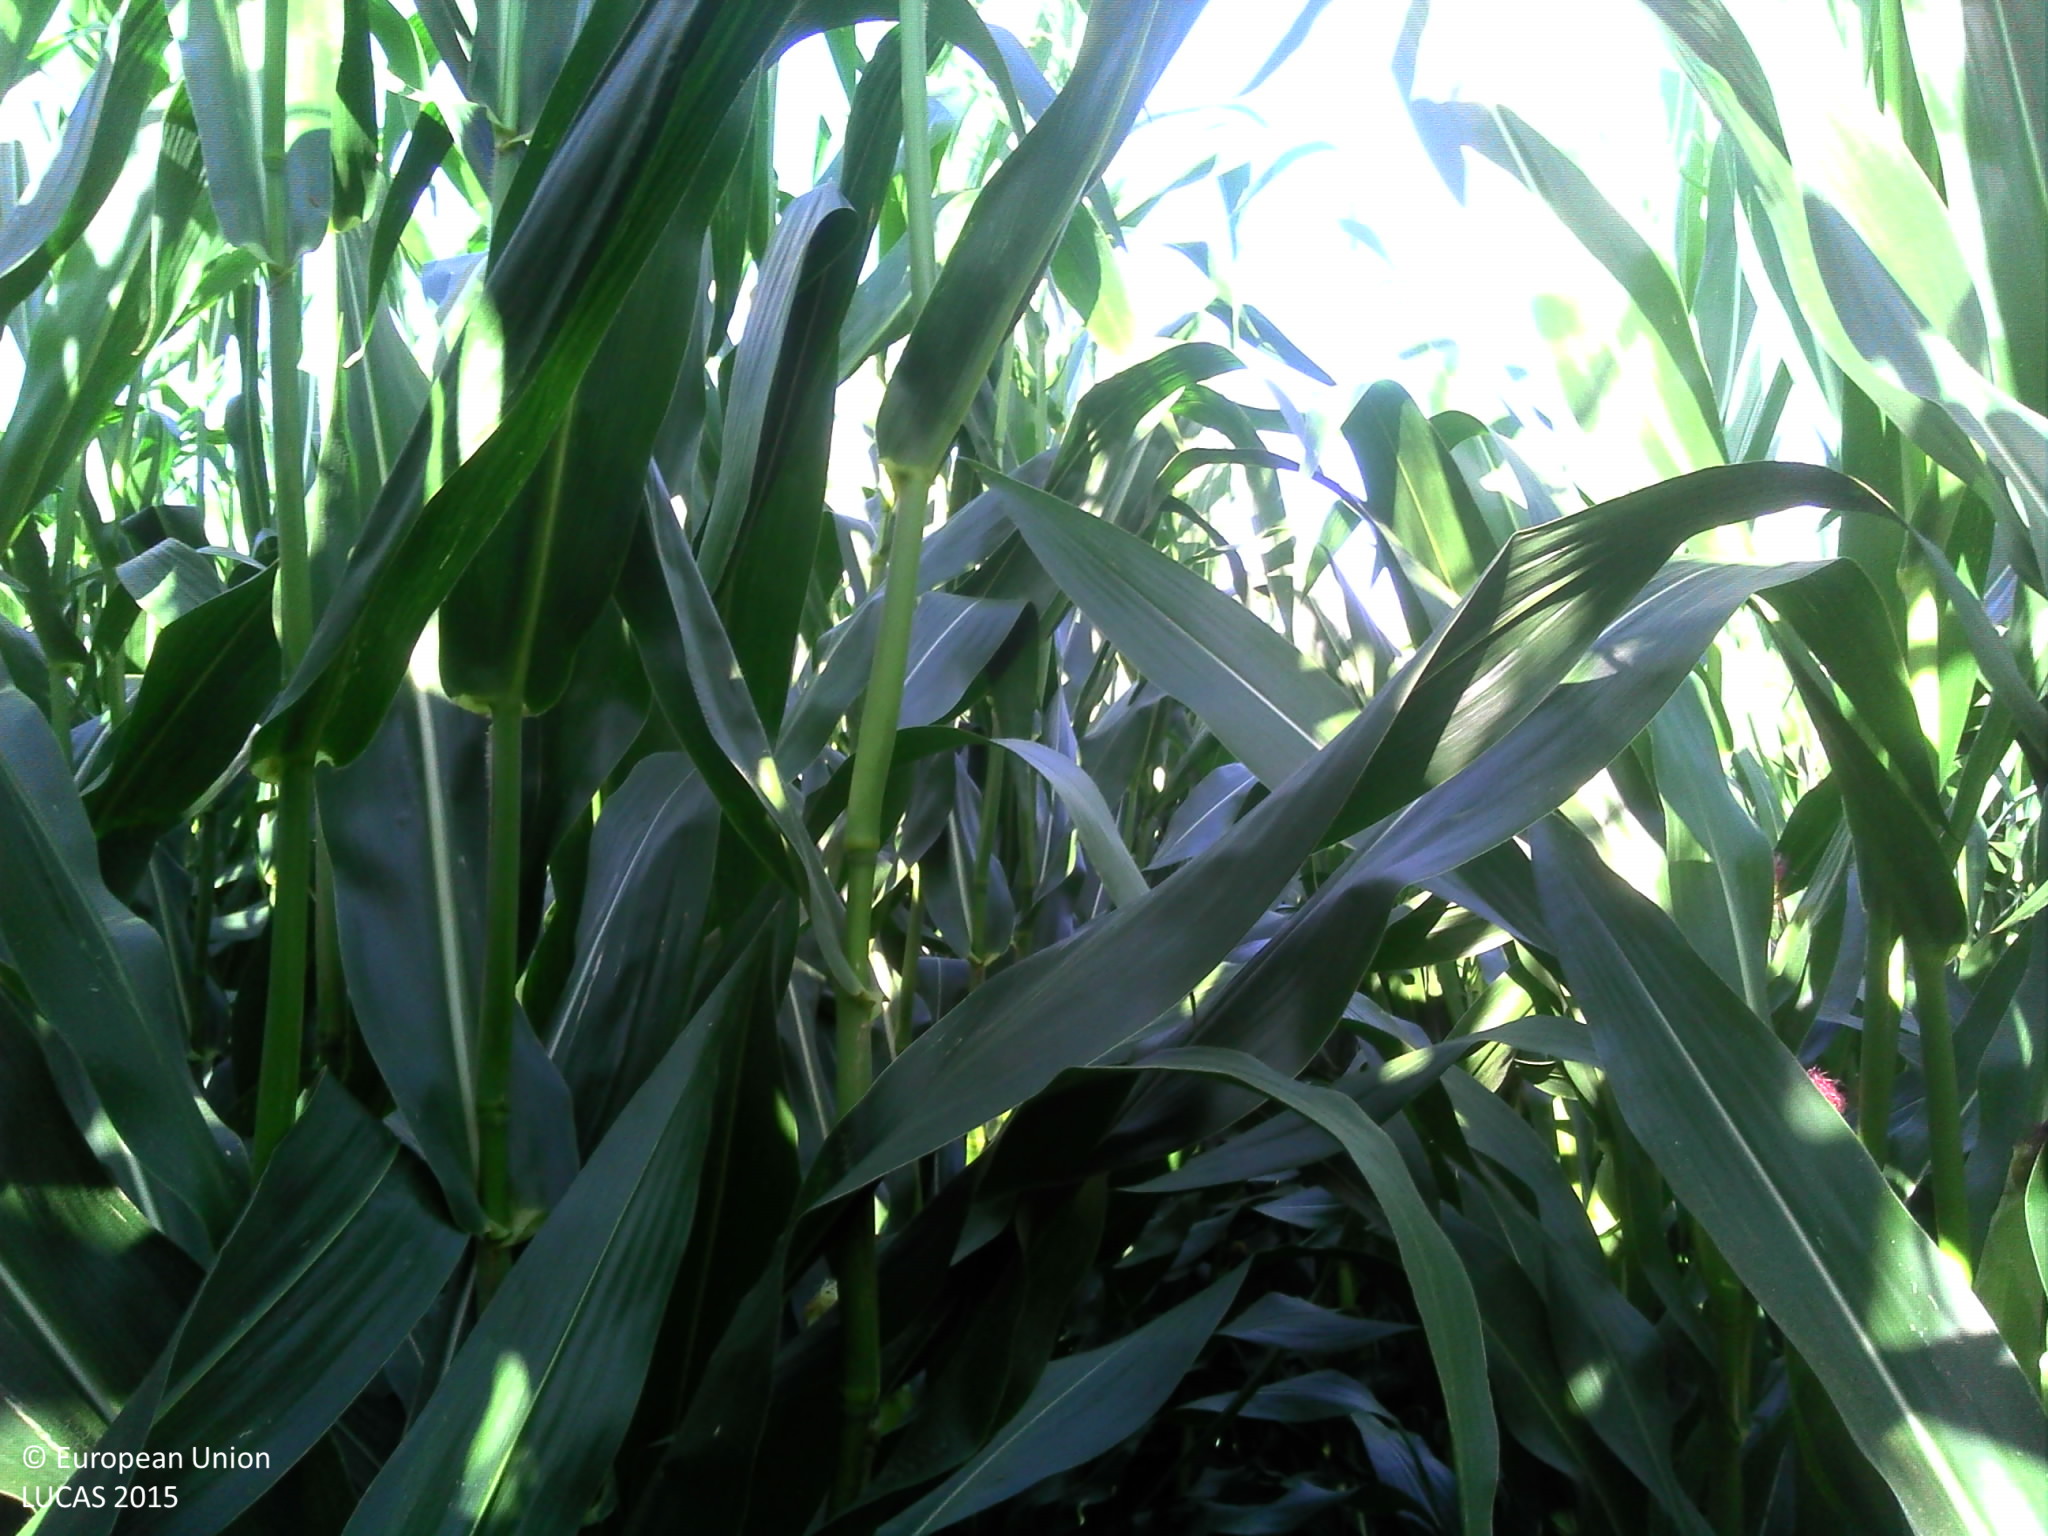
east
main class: Cropland
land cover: Maize
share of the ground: > 75 %
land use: Agriculture (excluding fallow land and kitchen gardens)
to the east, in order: Maize; Lines of trees; Ditches and canals; Artificial constructions in urban areas; Abandoned hedges; Fences; Grassland without tree/shrub cover
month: August
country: FR
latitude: 46.7589
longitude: -1.3889
